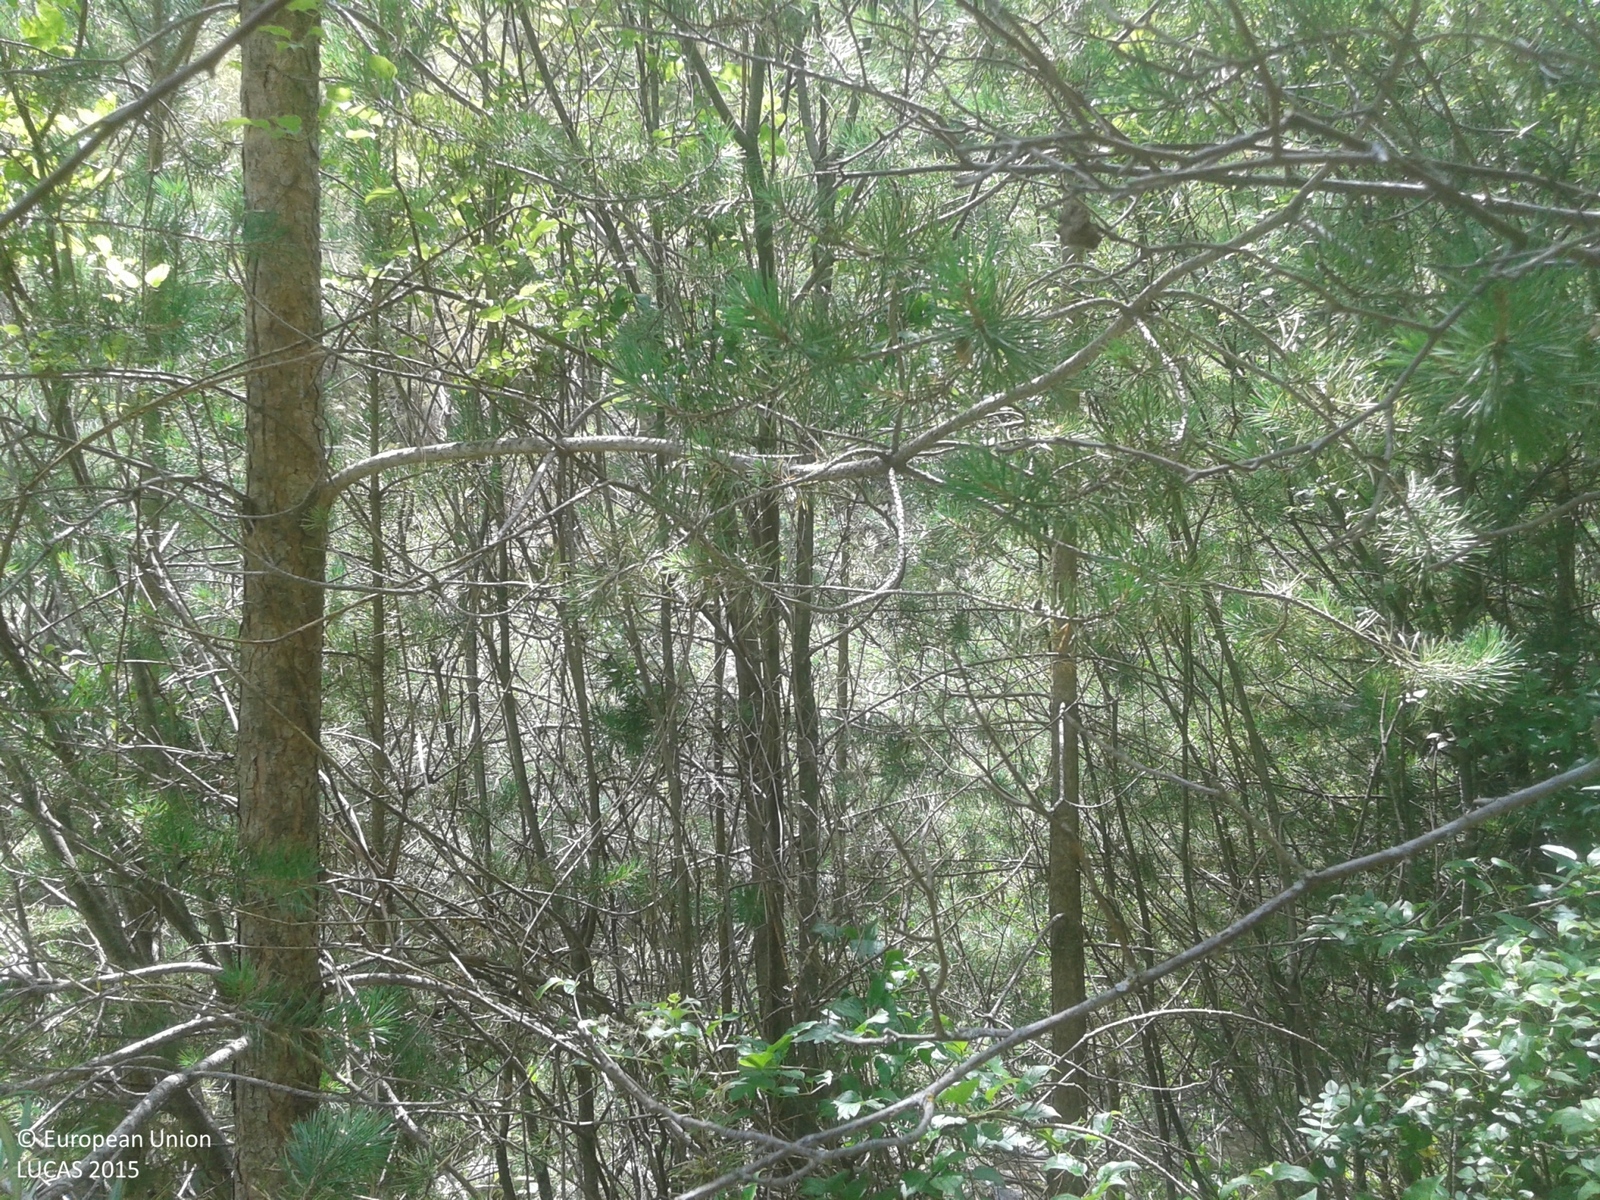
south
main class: Woodland
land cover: Other mixed woodland
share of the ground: > 75 %
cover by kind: broadleaved forest trees 65 %, coniferous forest trees 25 %, shrubs 5 %, herbaceous plants 5 %
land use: Semi-natural and natural areas not in use
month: July
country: ES
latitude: 42.2511
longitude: 1.6117
